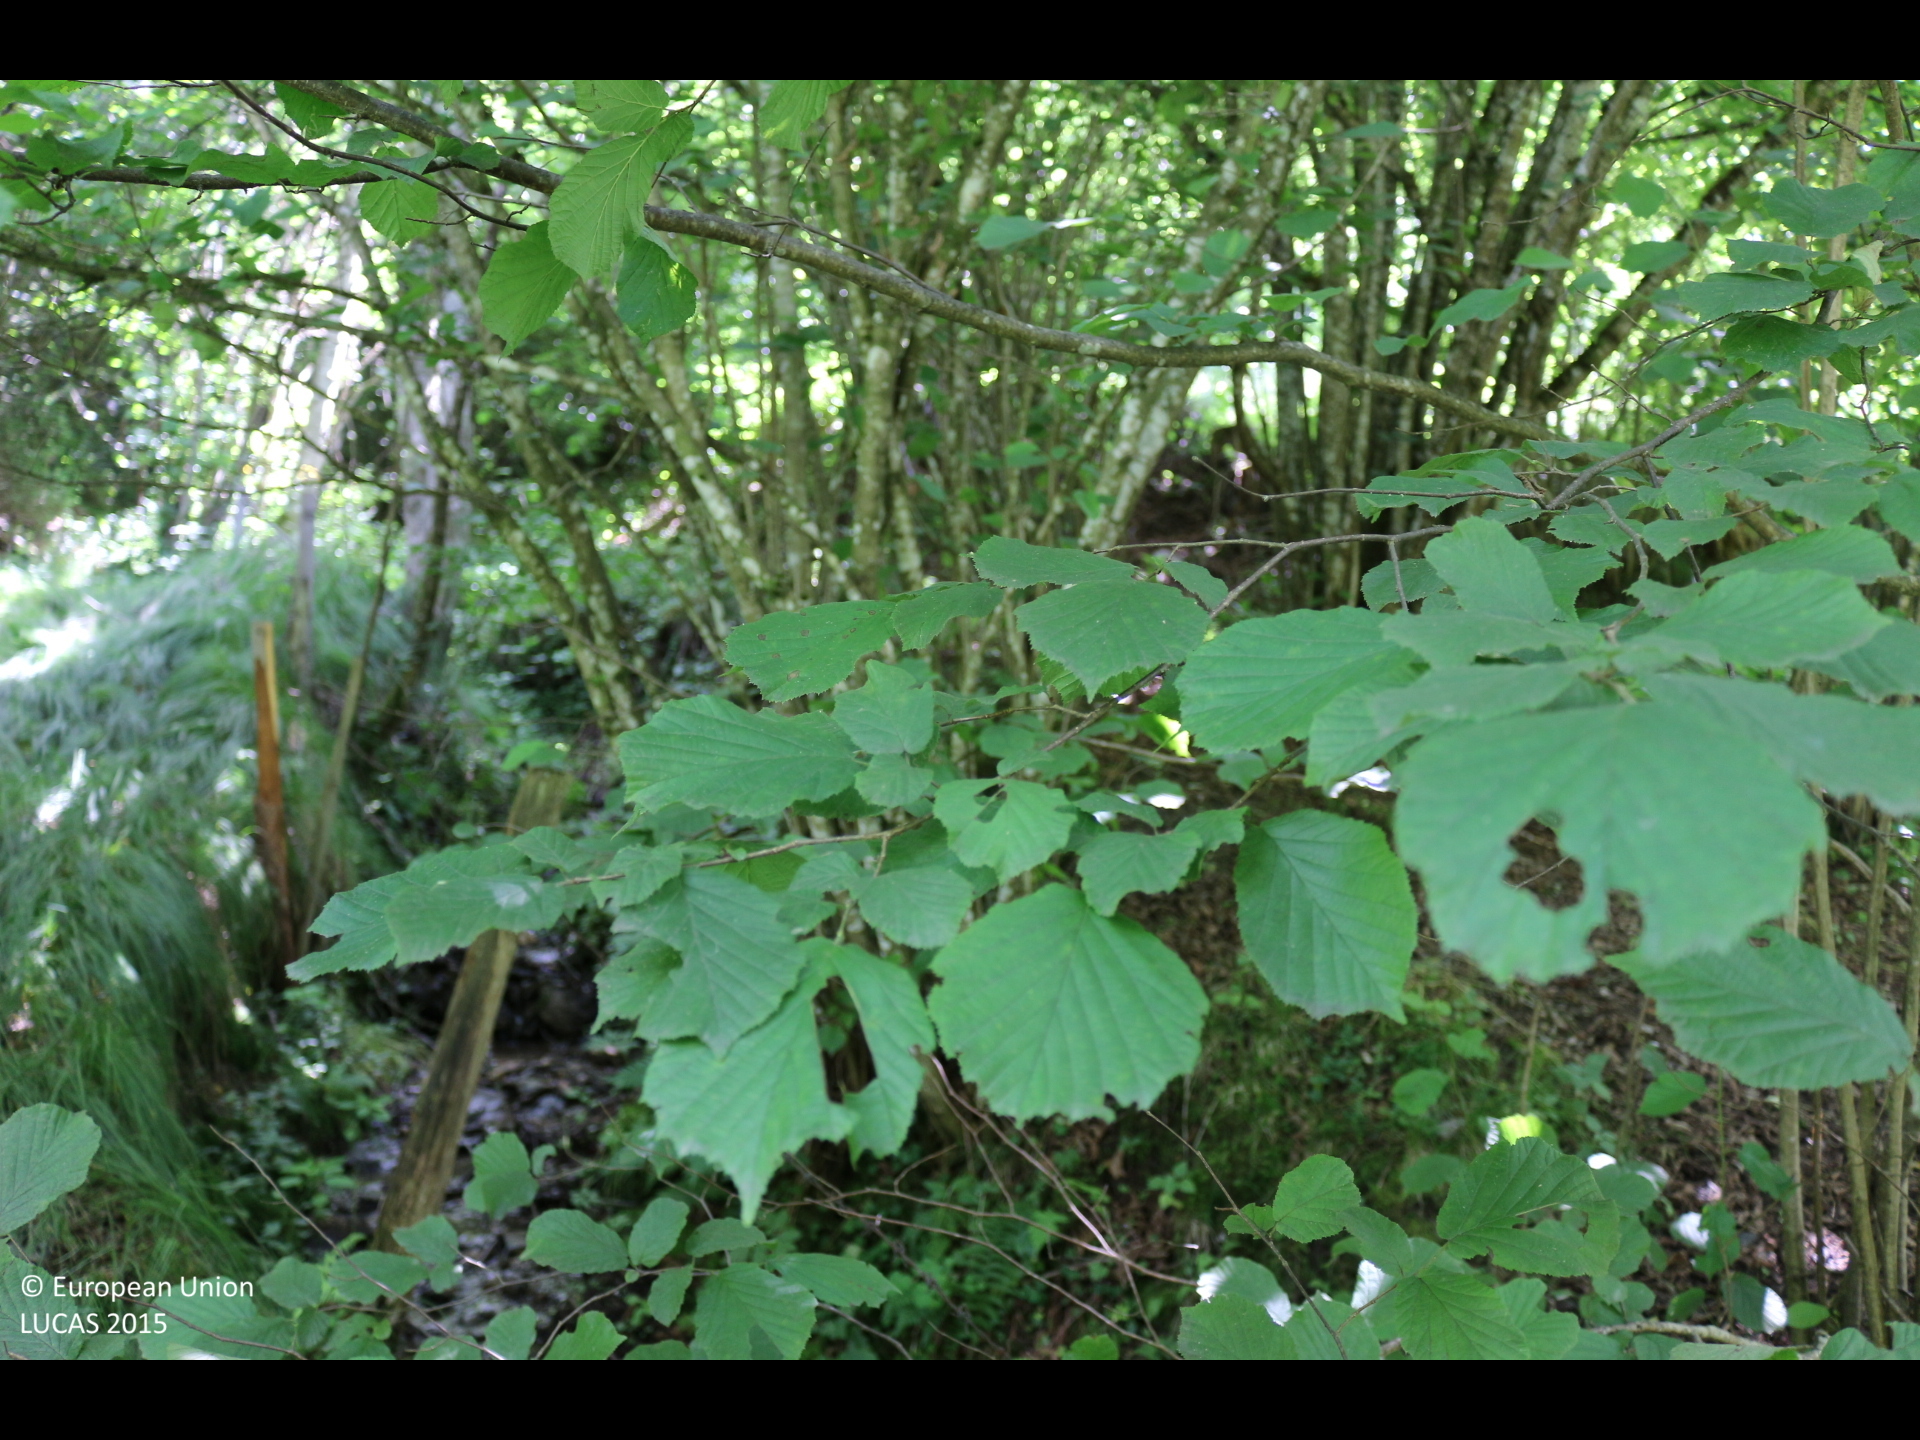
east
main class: Shrubland
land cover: Shrubland with sparse tree cover
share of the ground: > 75 %
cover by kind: shrubs 90 %, broadleaved forest trees 5 %, herbaceous plants 5 %
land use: Forestry
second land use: Agriculture (excluding fallow land and kitchen gardens)
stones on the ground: < 10 %
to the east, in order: Shrubland with sparse tree cover; Grassland with sparse tree/shrub cover; Broadleaved woodland; Fences; Grass margins; Tracks; Broadleaved woodland; Electric lines; Broadleaved woodland; Spruce dominated mixed woodland; Rivers and streams; Grassland without tree/shrub cover; Electric lines; Grassland without tree/shrub cover; Fences; Grass margins; Electric lines; Tracks; Grass margins; Lines of trees; Grassland without tree/shrub cover; Fences; Shrubland without tree cover; Broadleaved woodland; Fences; Broadleaved woodland; Grassland with sparse tree/shrub cover
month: June
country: AT
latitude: 46.9005
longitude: 14.1853
